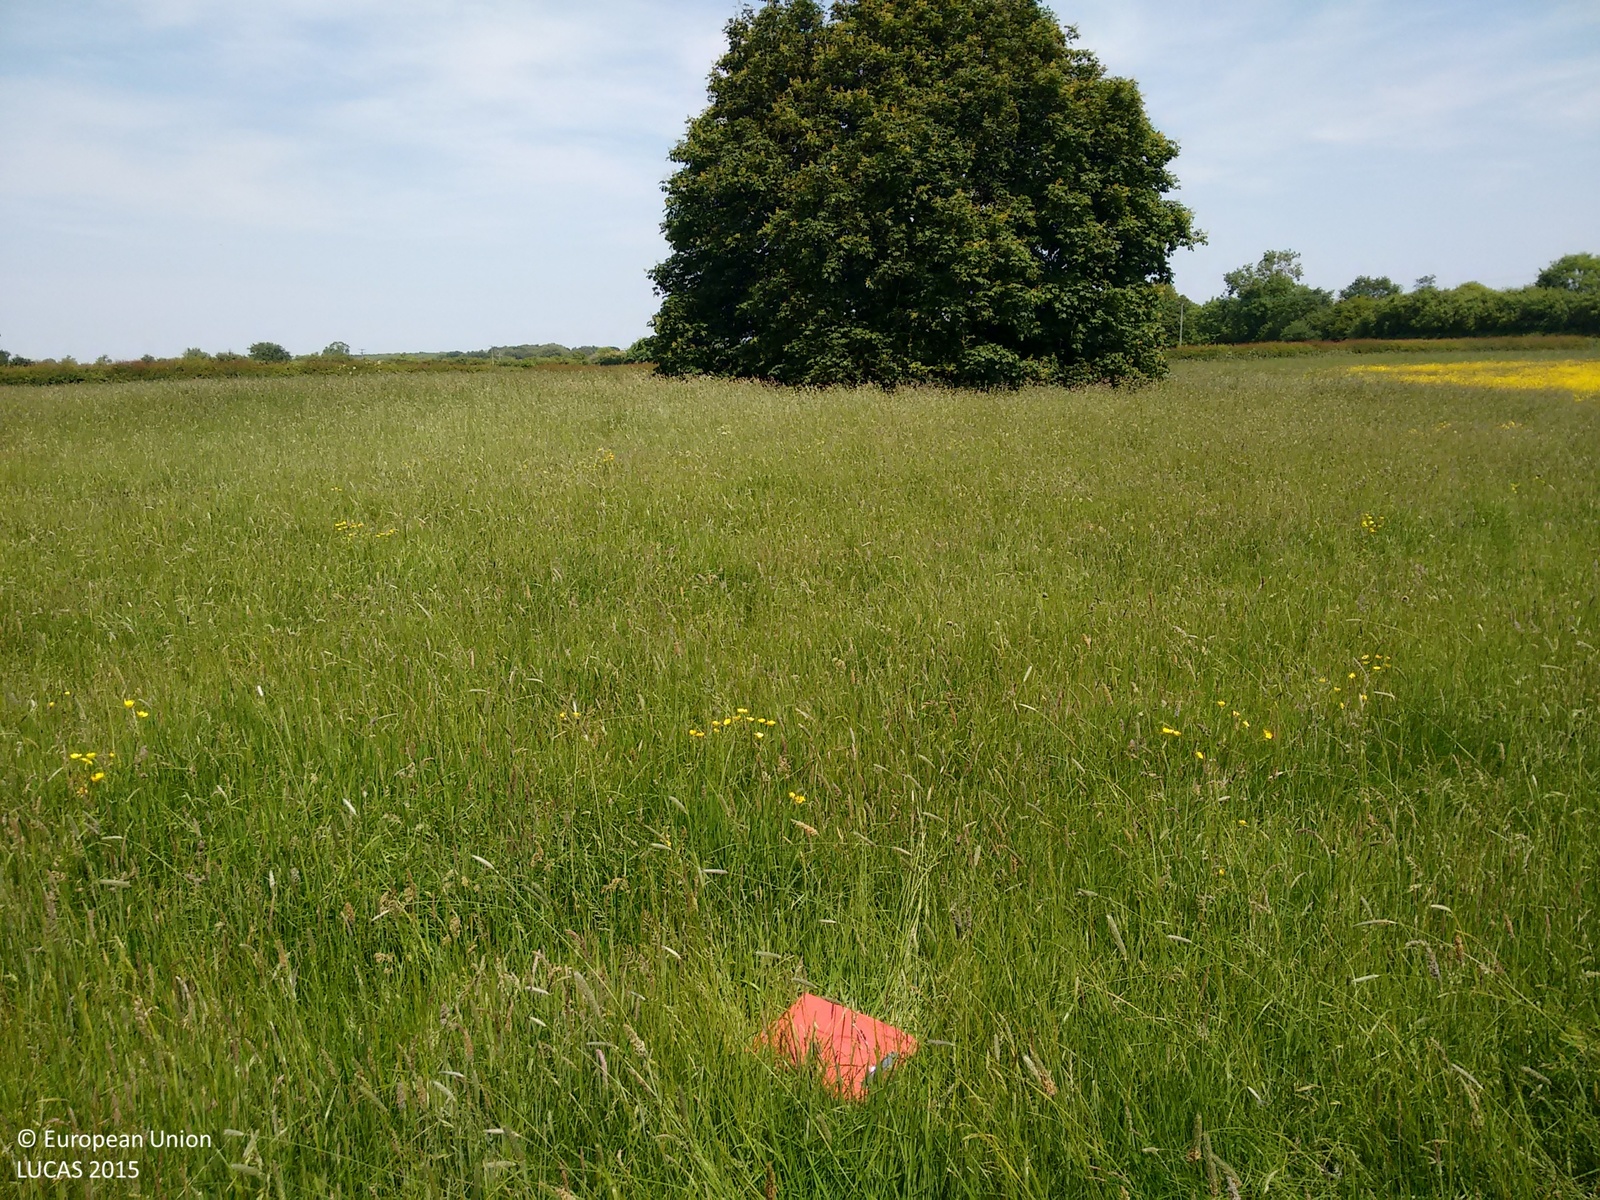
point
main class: Grassland
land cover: Grassland without tree/shrub cover
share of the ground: > 75 %
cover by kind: herbaceous plants 95 %, shrubs 5 %
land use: Agriculture (excluding fallow land and kitchen gardens)
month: June
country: GB
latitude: 53.8088
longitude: -1.1767
